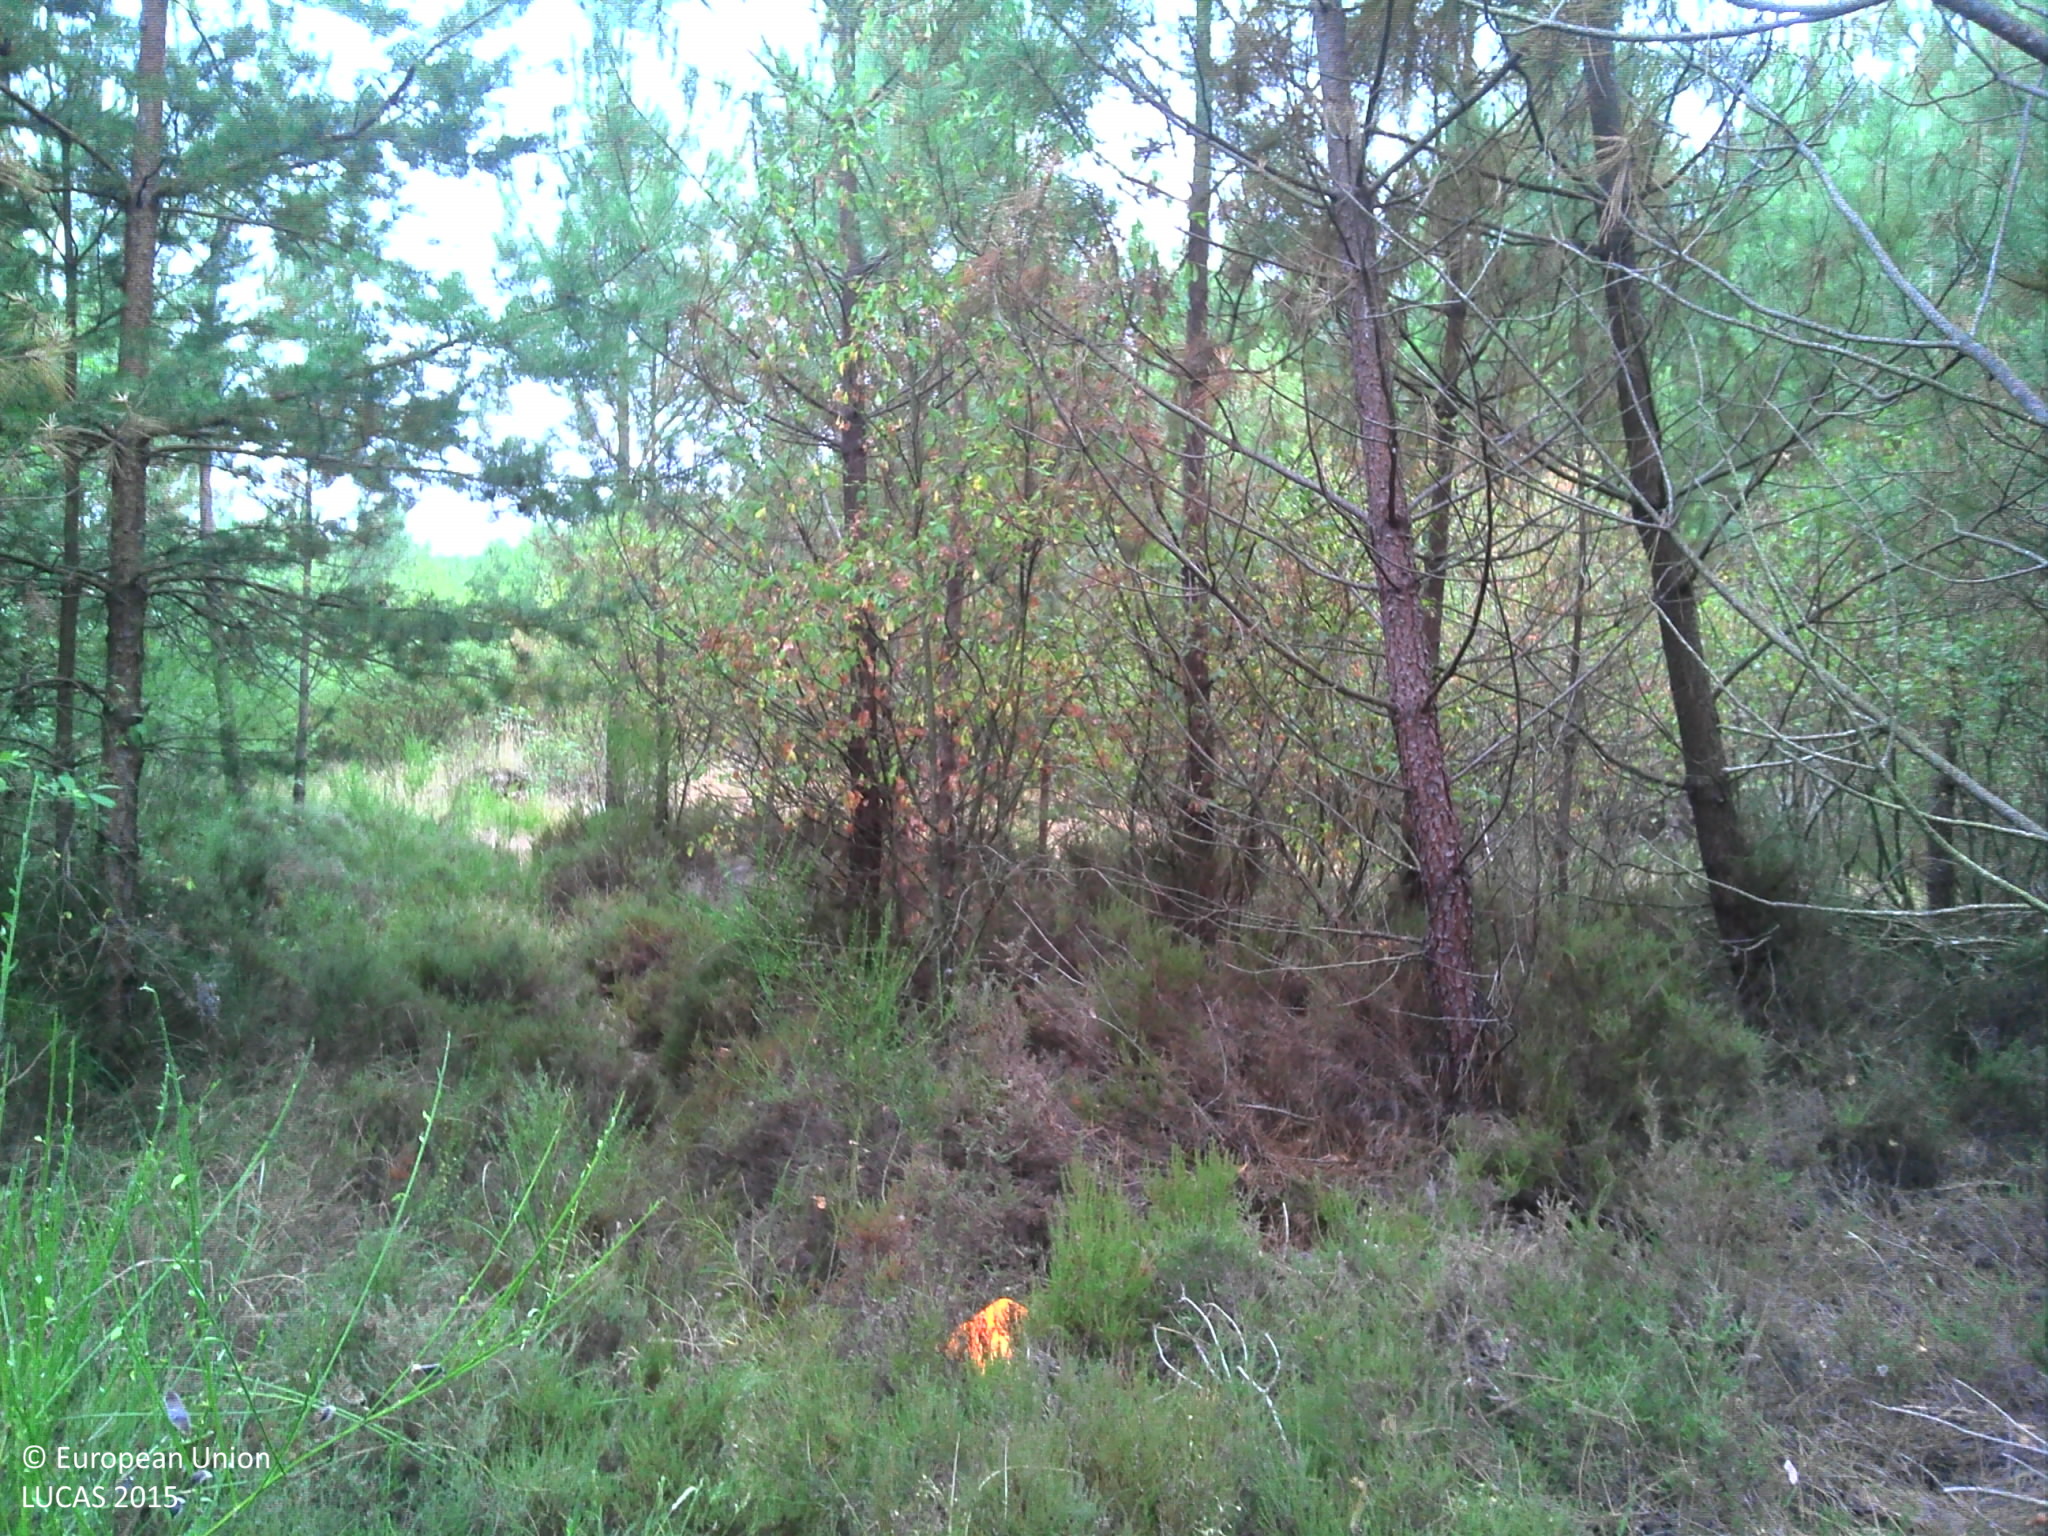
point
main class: Woodland
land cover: Pine dominated coniferous woodland
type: exotic forest
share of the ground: > 75 %
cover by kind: coniferous forest trees 70 %, shrubs 15 %, herbaceous plants 15 %
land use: Forestry
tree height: > 5 m
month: July
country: FR
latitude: 47.9240
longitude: 0.3263
